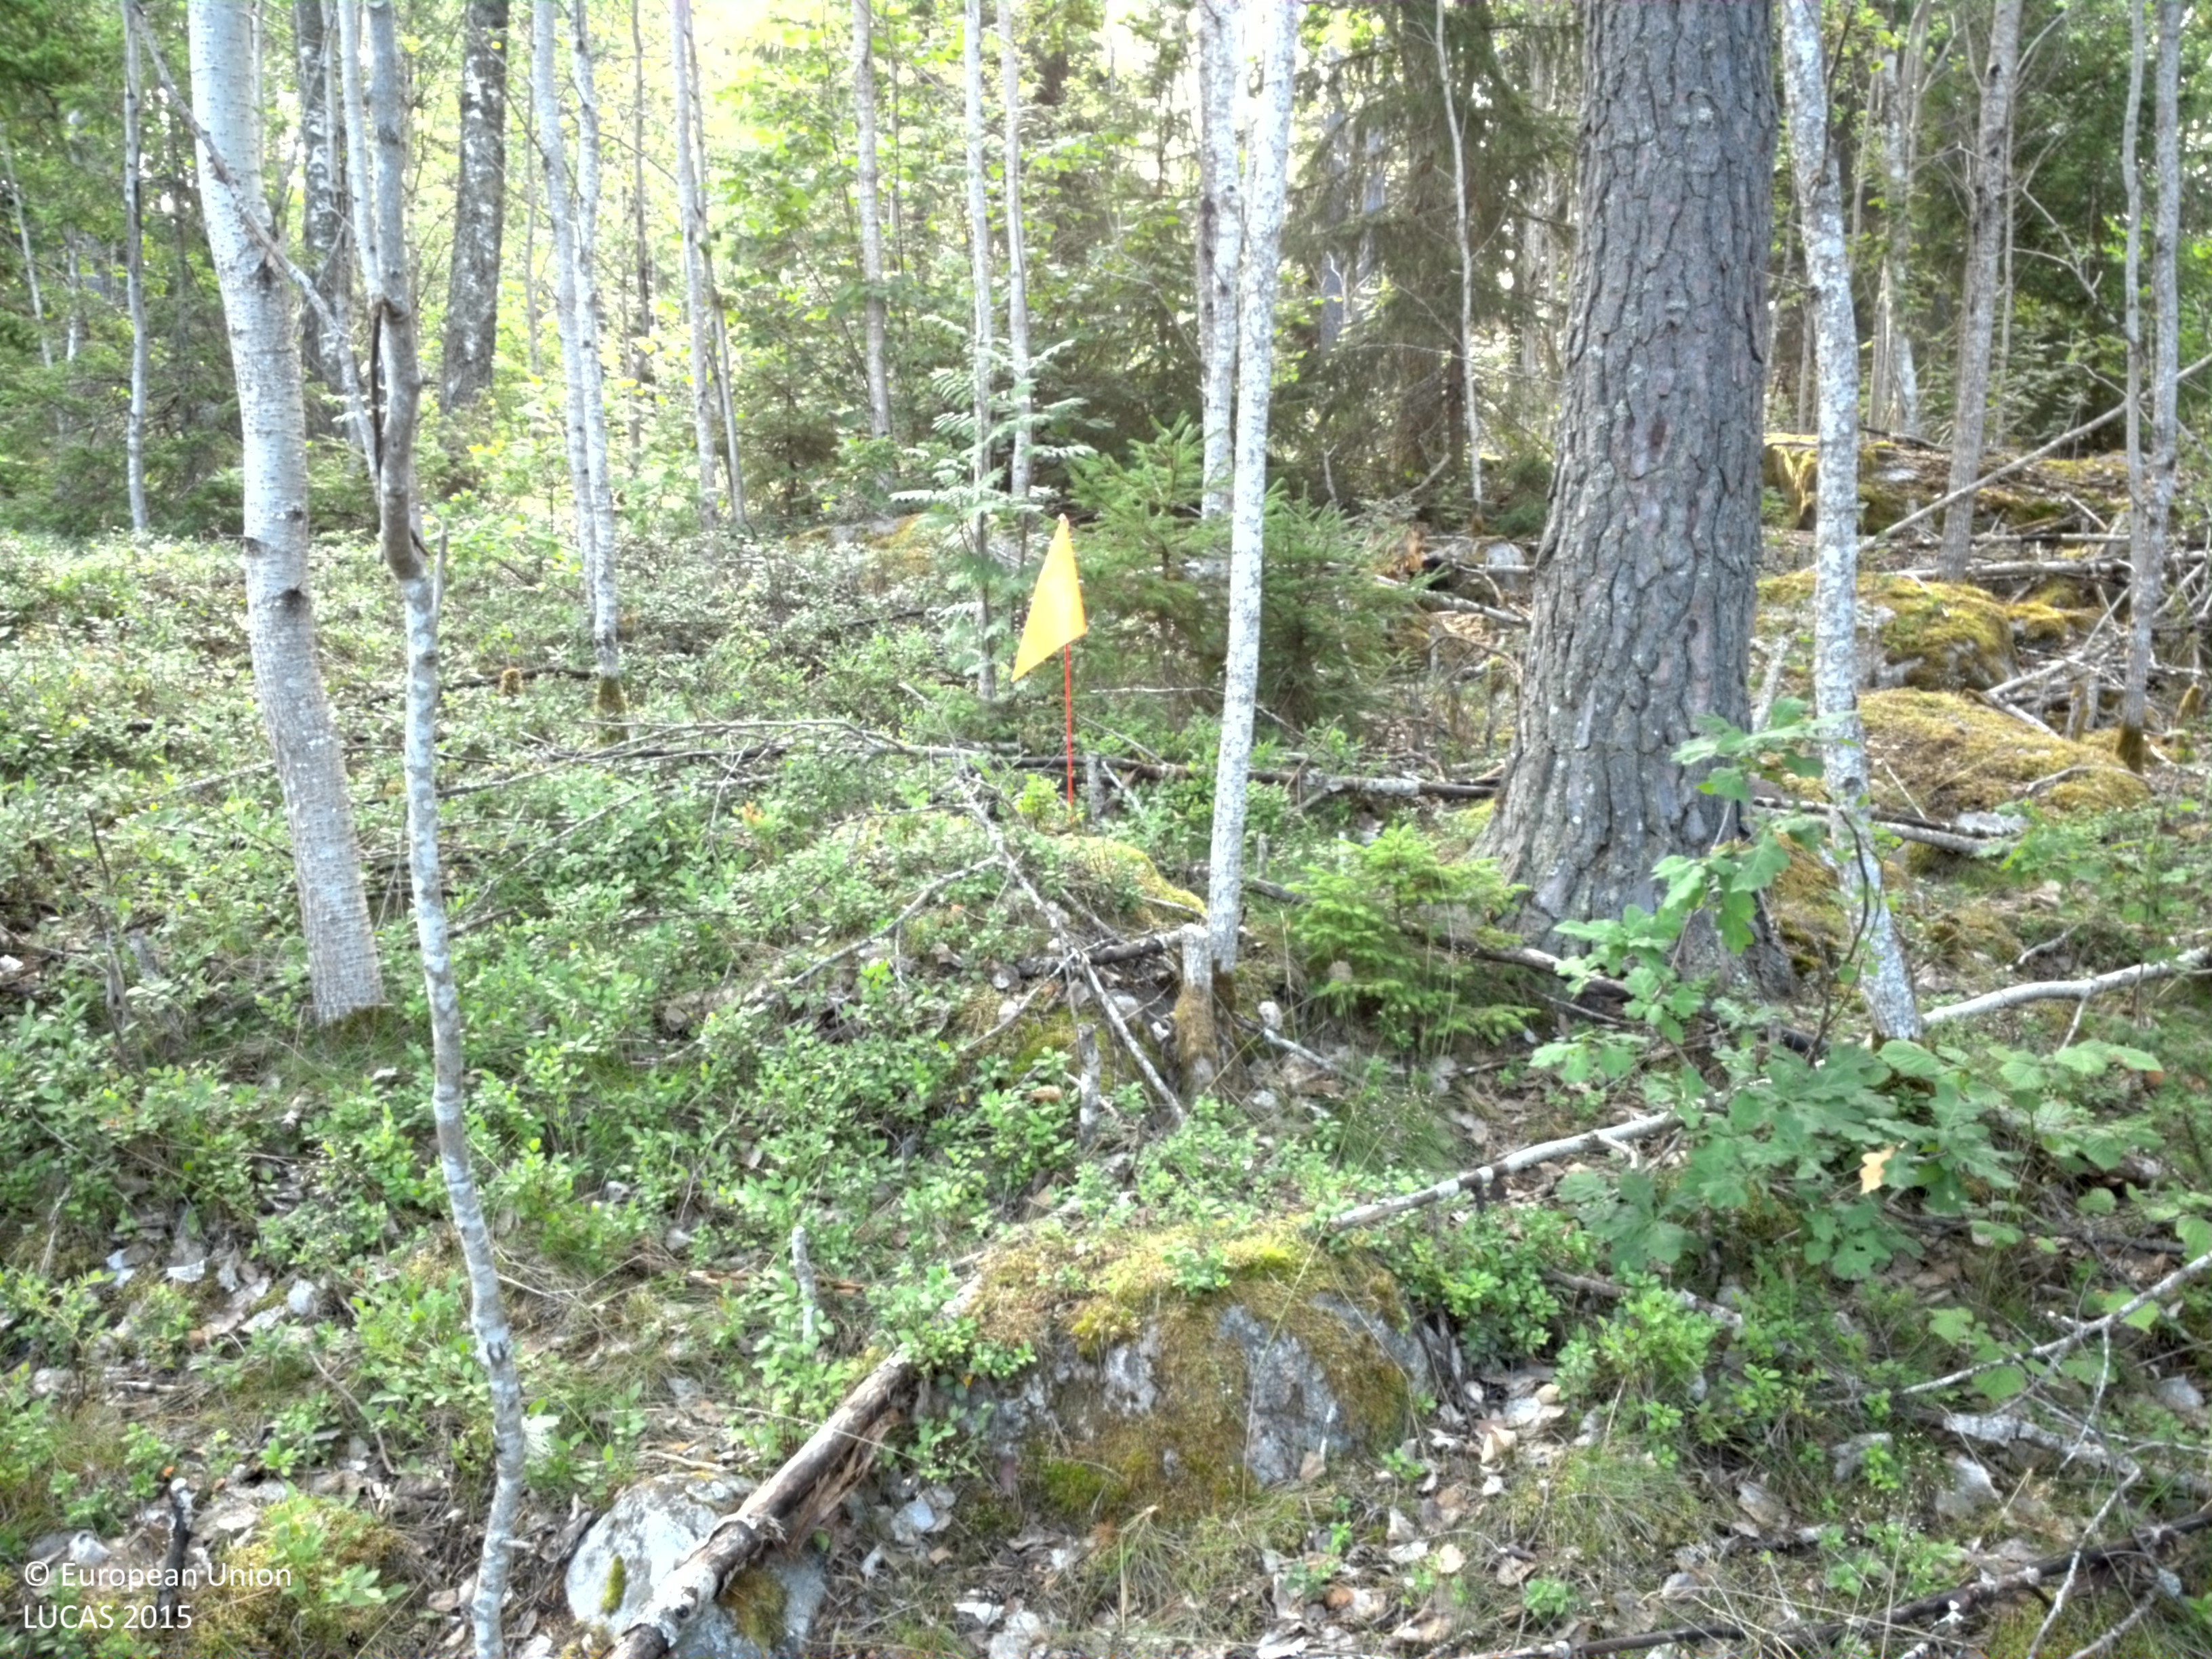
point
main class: Woodland
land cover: Pine dominated mixed woodland
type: boreal forest
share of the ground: > 75 %
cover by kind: coniferous forest trees 50 %, broadleaved forest trees 30 %, lichens and mosses 20 %
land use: Forestry
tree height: > 5 m
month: July
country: SE
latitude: 59.8063
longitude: 18.6451
